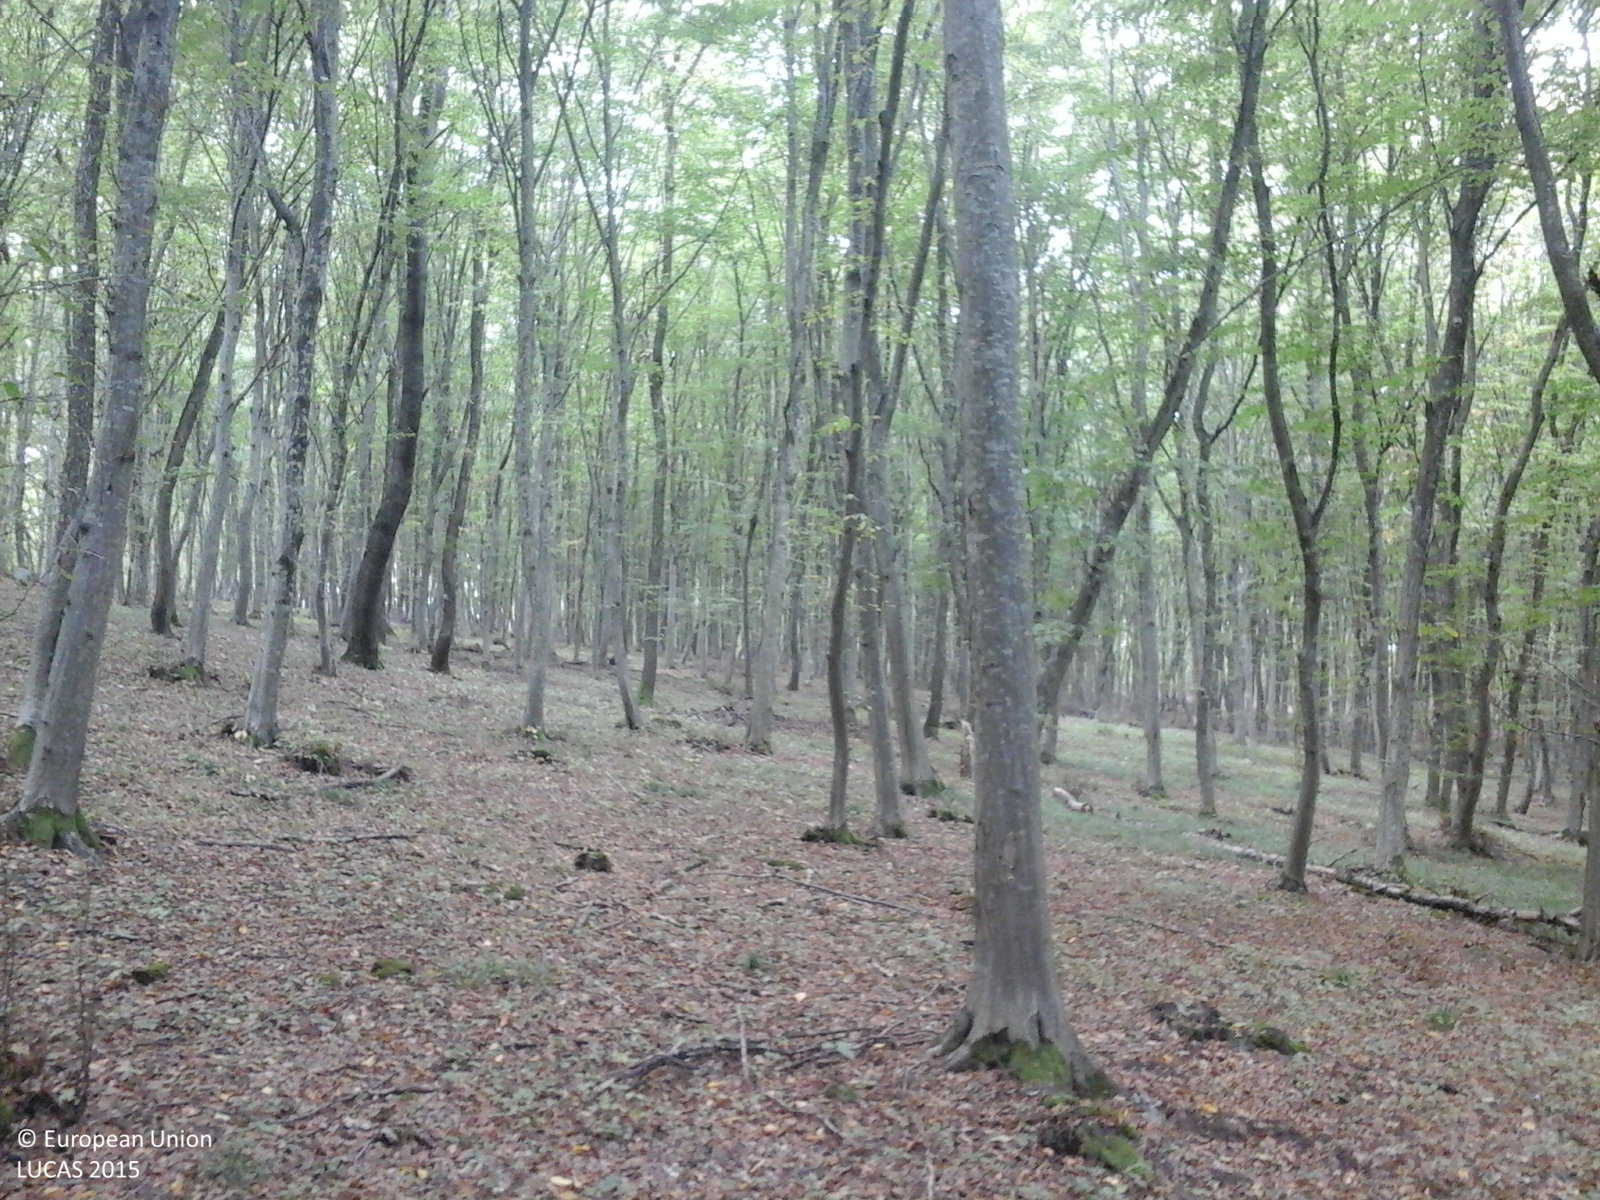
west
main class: Woodland
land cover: Broadleaved woodland
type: beech forest
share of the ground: > 75 %
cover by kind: broadleaved forest trees 100 %
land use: Forestry
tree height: > 5 m
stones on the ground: < 10 %
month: October
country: RO
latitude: 46.6548
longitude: 24.7681
